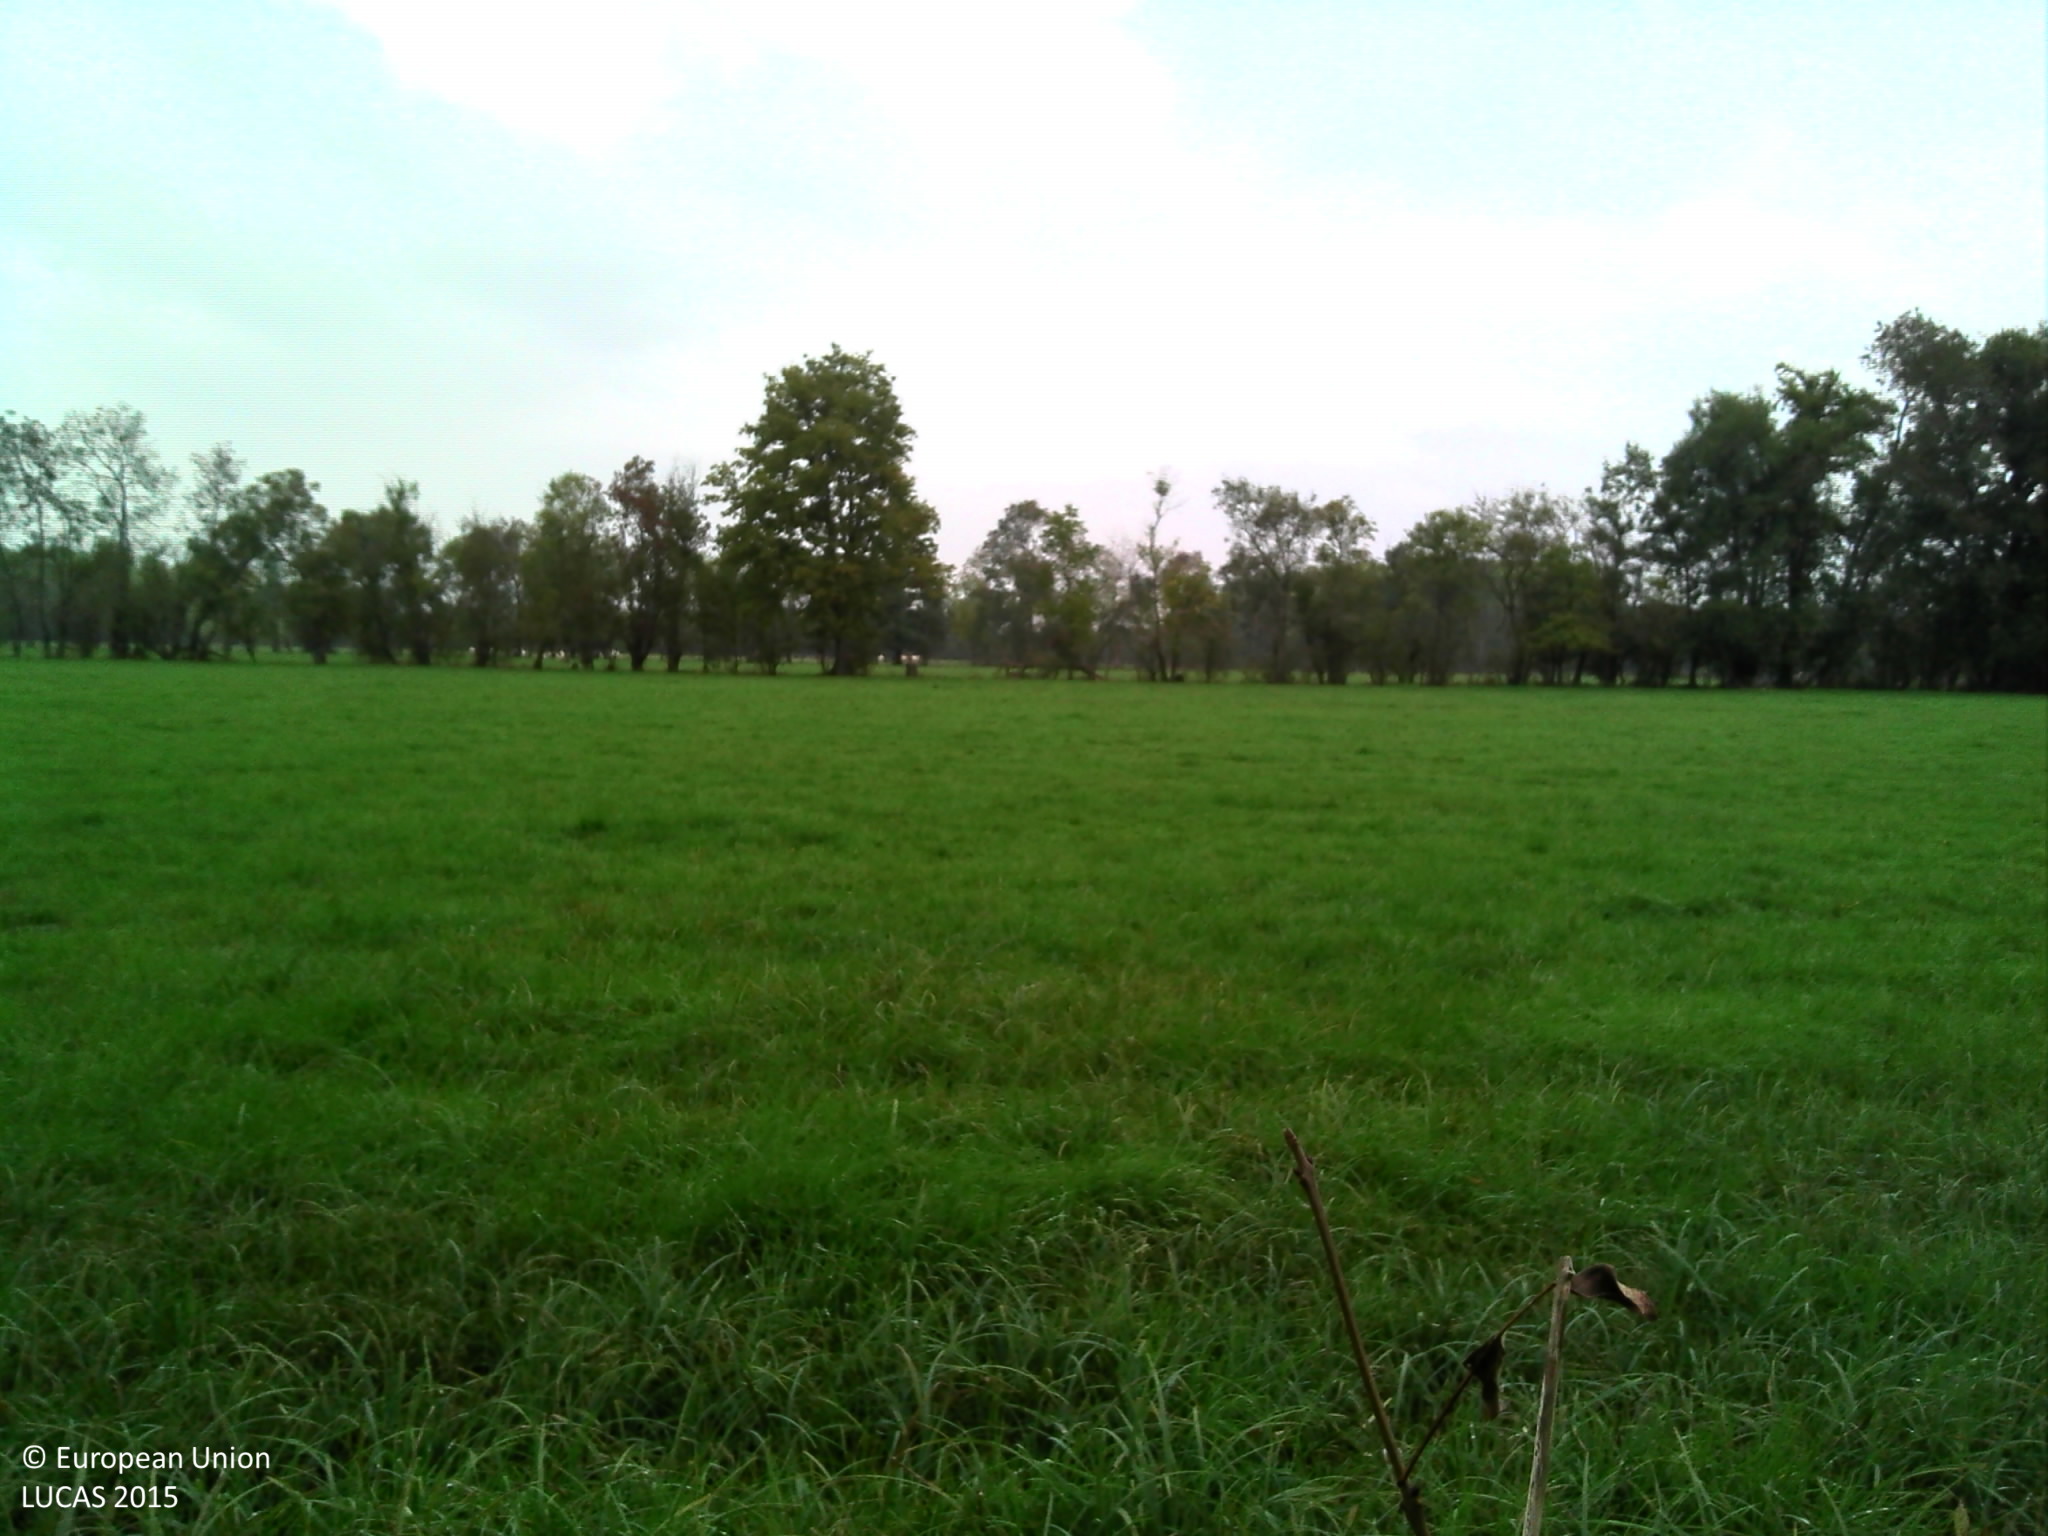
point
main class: Grassland
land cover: Grassland without tree/shrub cover
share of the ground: > 75 %
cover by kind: herbaceous plants 100 %
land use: Agriculture (excluding fallow land and kitchen gardens)
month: October
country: FR
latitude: 46.2070
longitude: 4.8052
